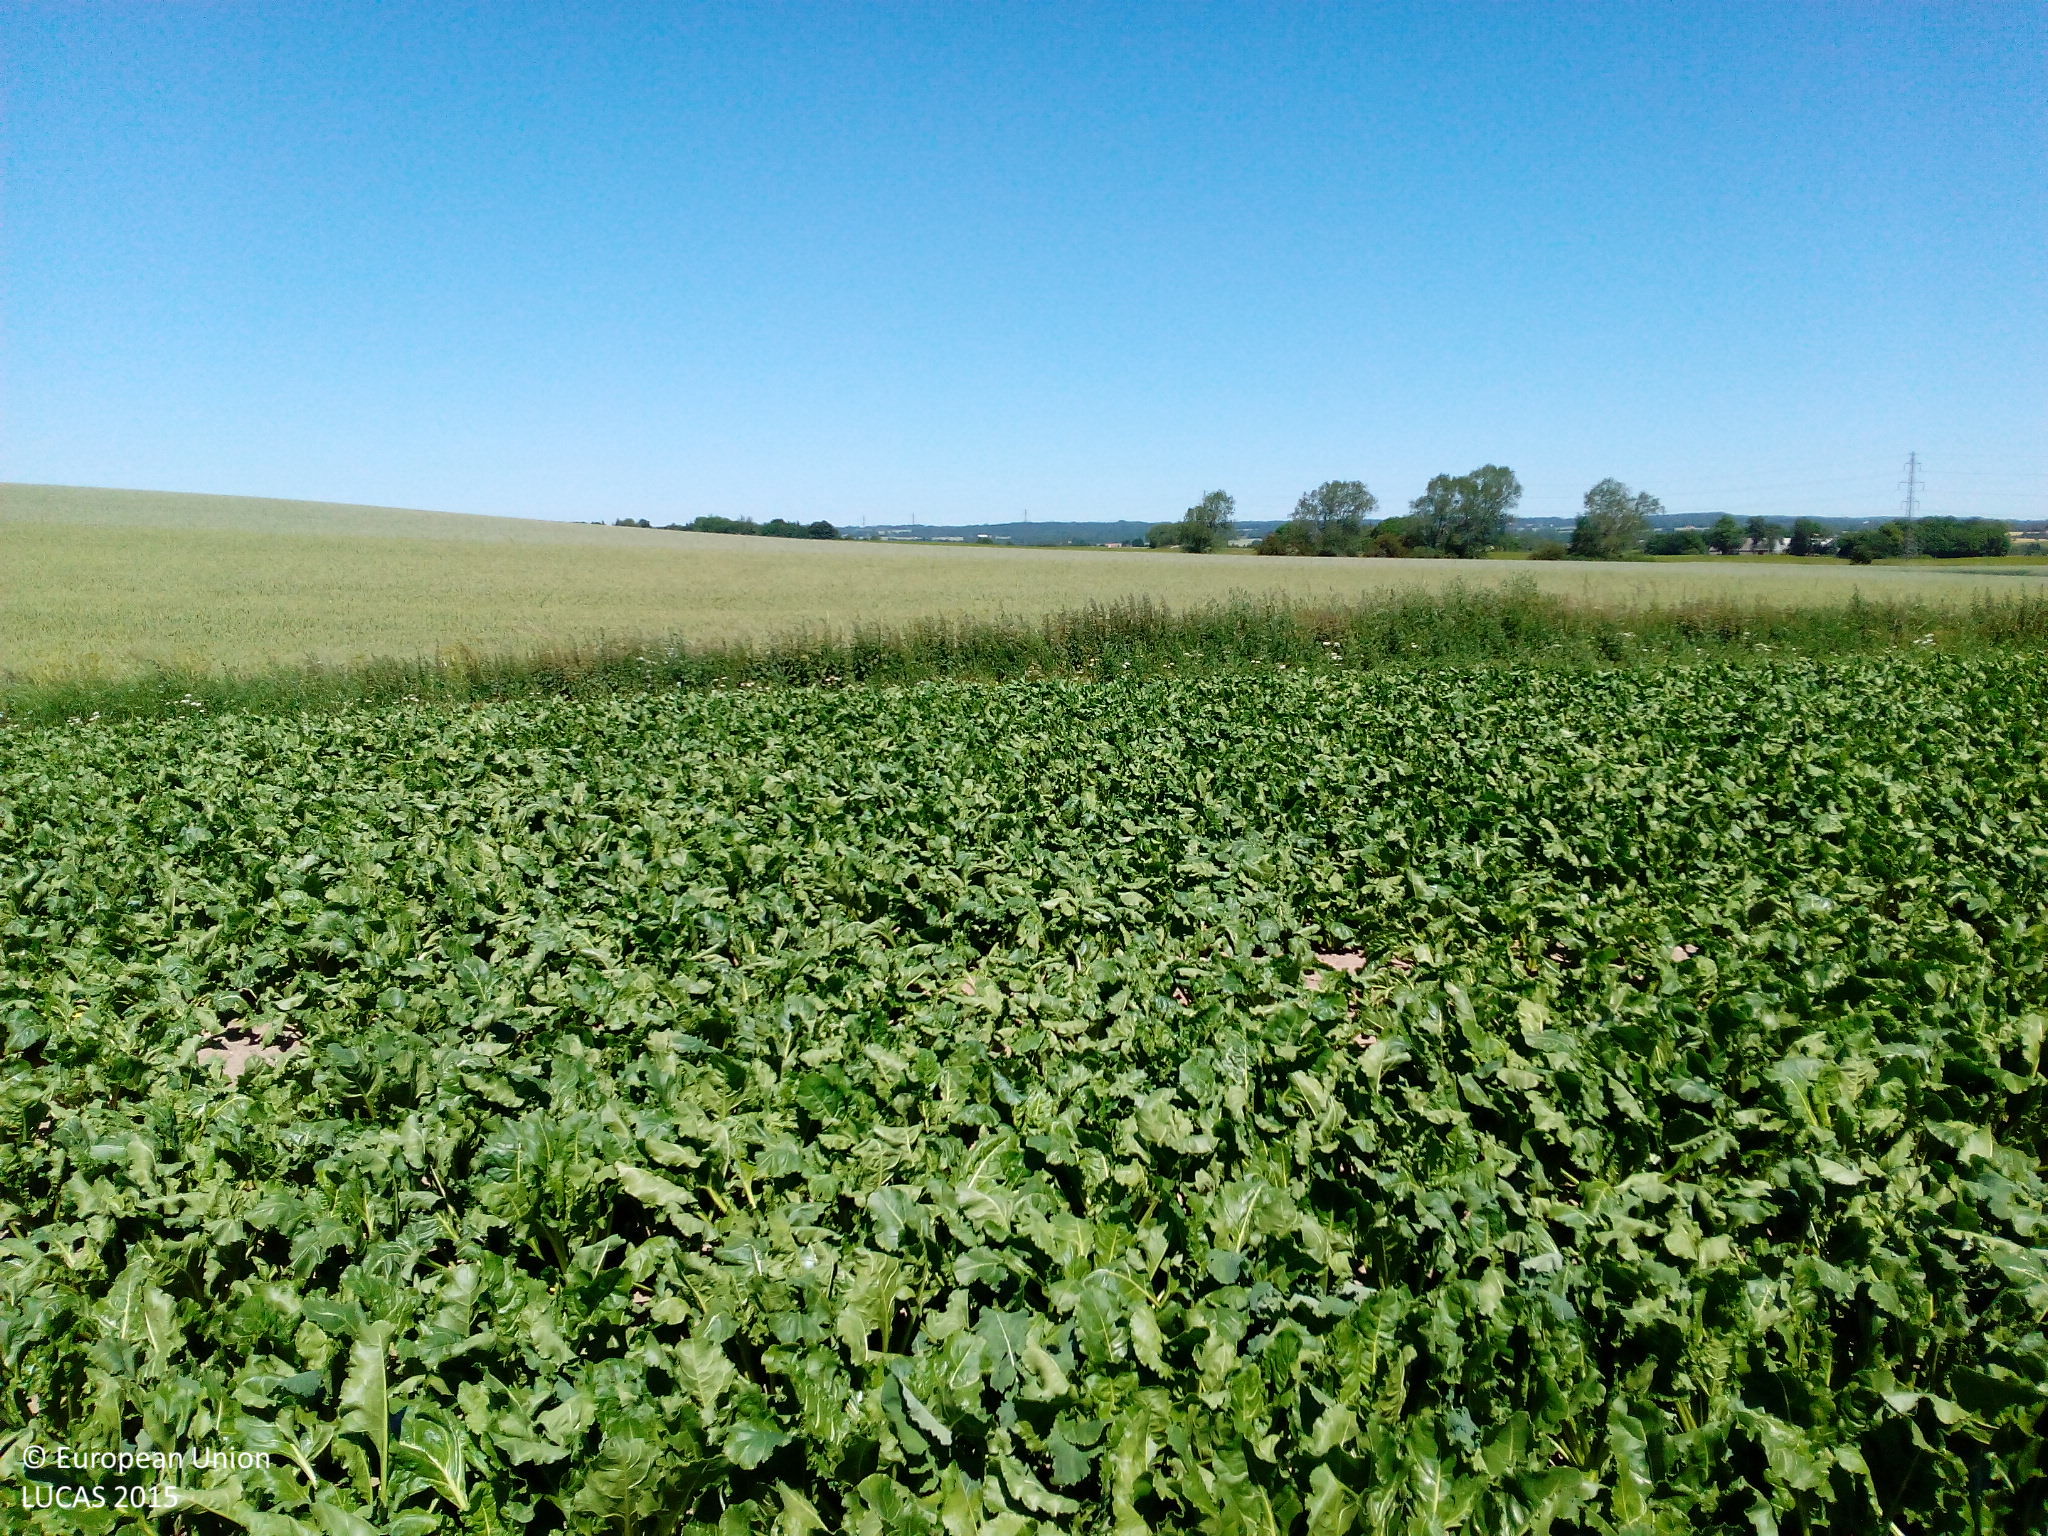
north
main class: Cropland
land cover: Sugar beet
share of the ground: > 75 %
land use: Agriculture (excluding fallow land and kitchen gardens)
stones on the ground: < 10 %
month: July
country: DK
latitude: 55.1489
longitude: 11.8973
